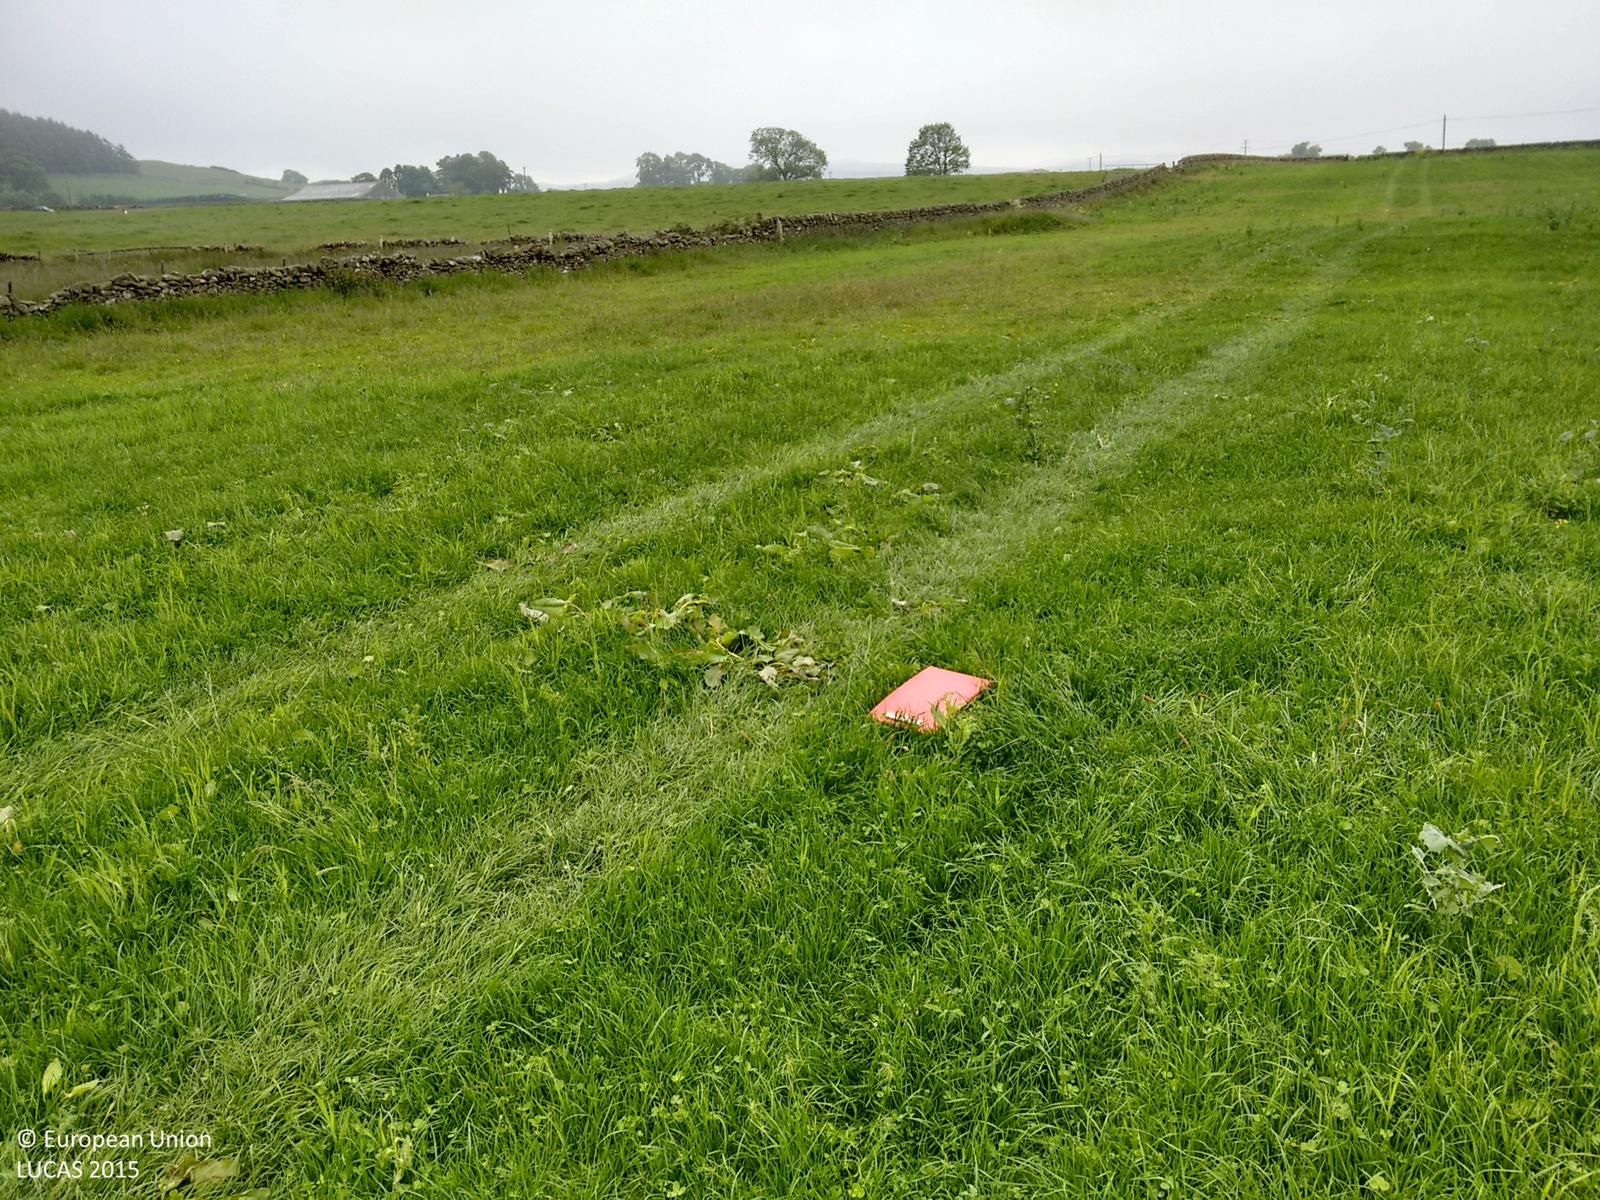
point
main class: Grassland
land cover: Grassland without tree/shrub cover
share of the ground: > 75 %
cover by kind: herbaceous plants 100 %
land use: Agriculture (excluding fallow land and kitchen gardens)
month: June
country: GB
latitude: 55.0798
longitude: -3.7284
